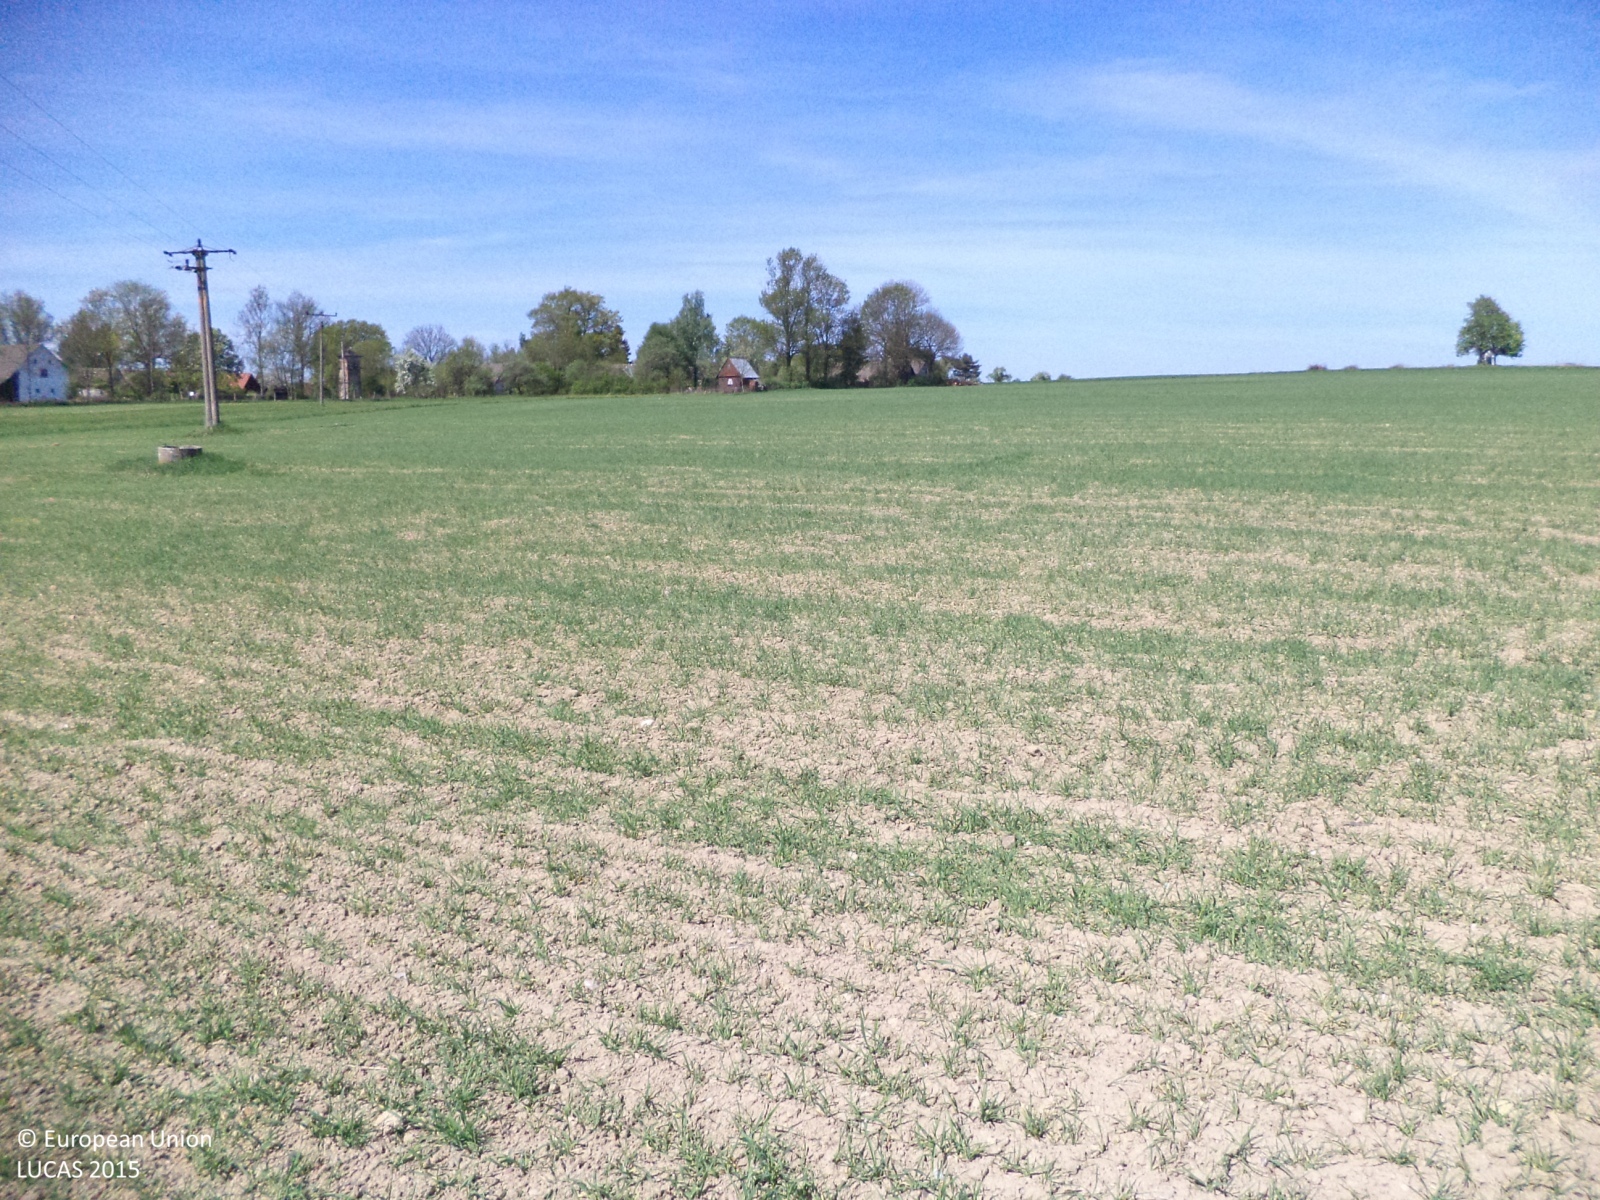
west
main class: Cropland
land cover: Barley
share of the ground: 25 - 50 %
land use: Agriculture (excluding fallow land and kitchen gardens)
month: May
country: CZ
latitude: 49.2580
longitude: 15.1277
